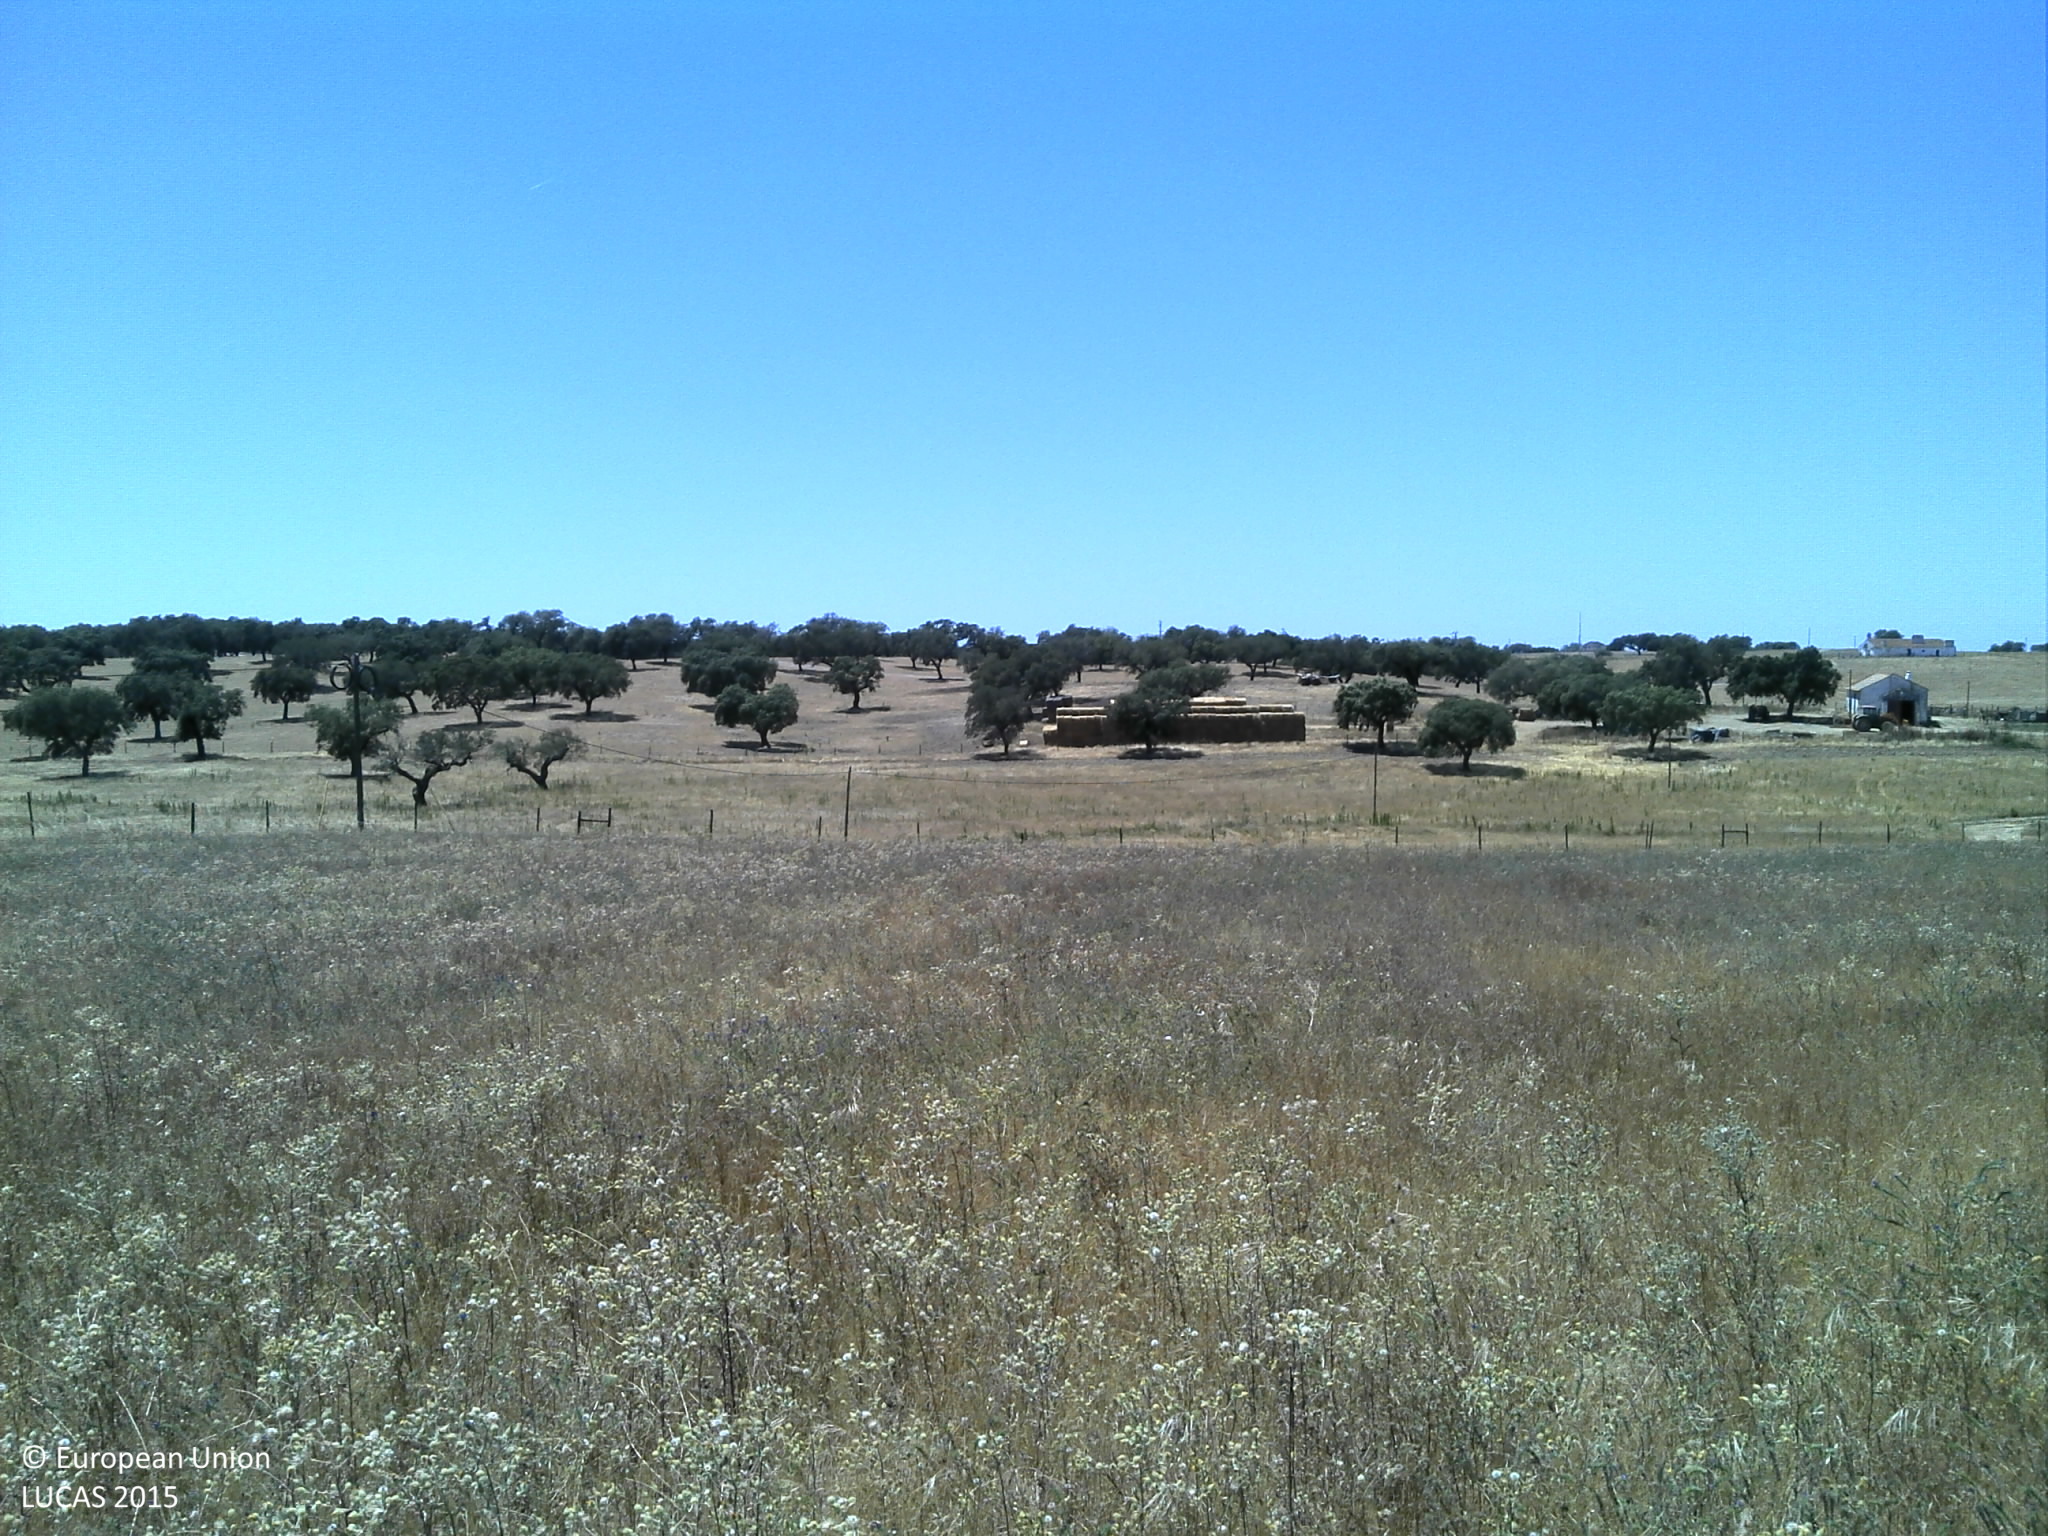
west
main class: Grassland
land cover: Spontaneously vegetated surfaces
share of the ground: > 75 %
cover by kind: herbaceous plants 90 %, unconsolidated bare surface 10 %
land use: Agriculture (excluding fallow land and kitchen gardens)
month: June
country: PT
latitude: 38.8336
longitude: -7.7700
